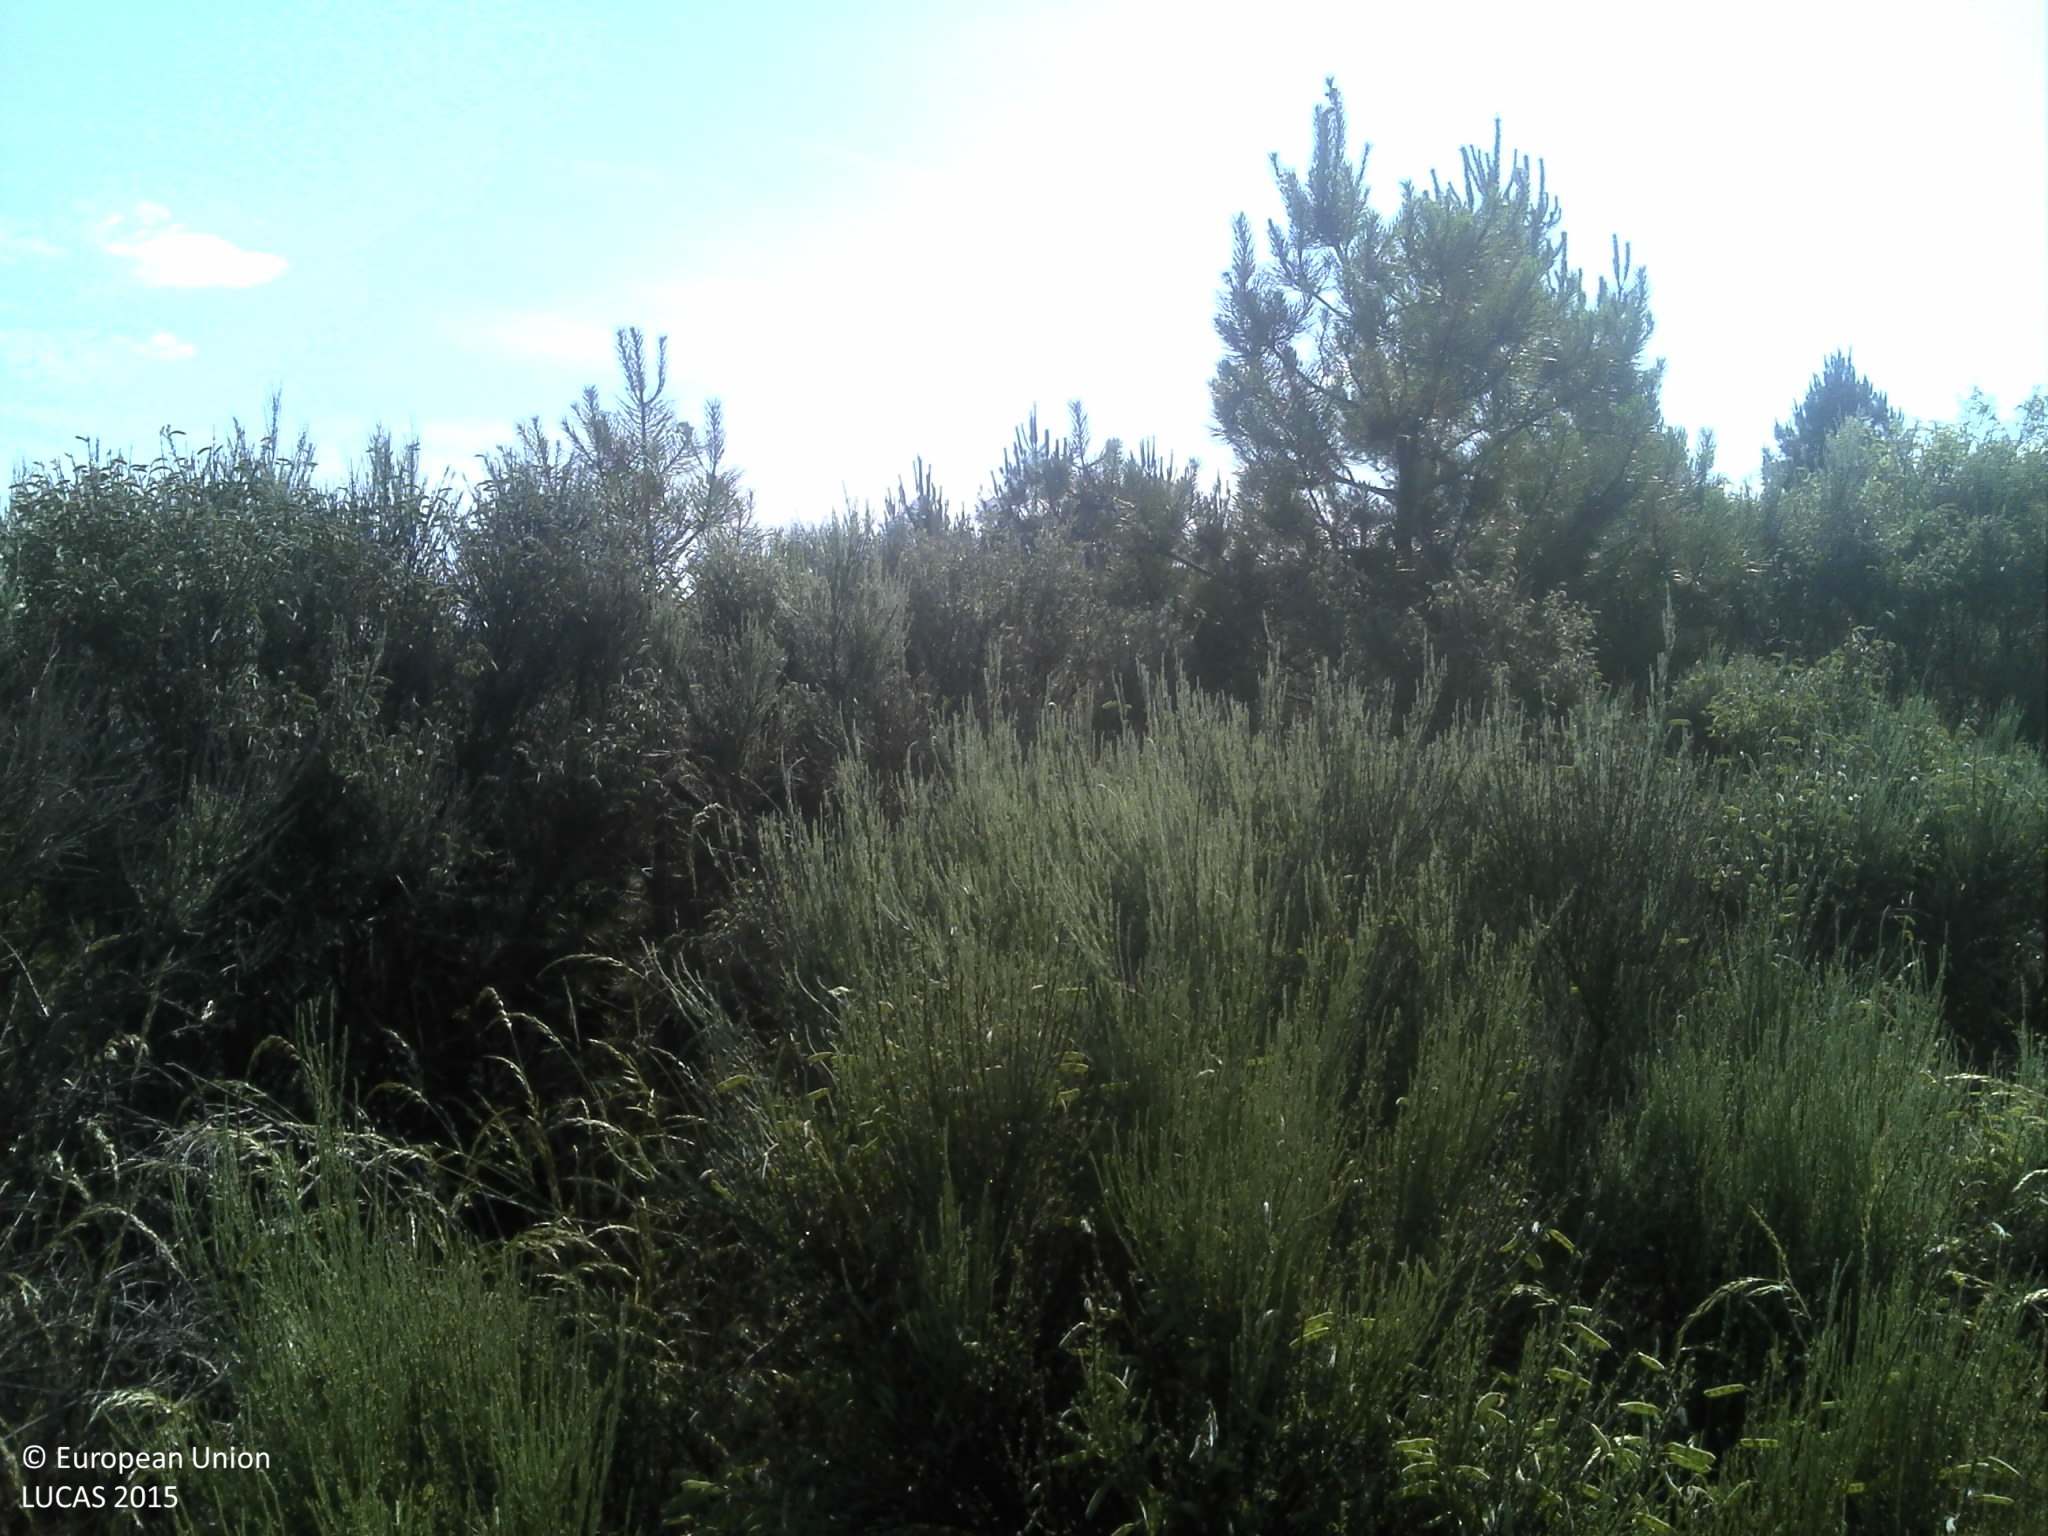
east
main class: Shrubland
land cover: Shrubland with sparse tree cover
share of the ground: 50 - 75 %
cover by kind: shrubs 75 %, unconsolidated bare surface 15 %, broadleaved forest trees 5 %, herbaceous plants 5 %
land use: Semi-natural and natural areas not in use
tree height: < 5 m
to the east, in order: Shrubland with sparse tree cover; Rocks and stones; Shrubland with sparse tree cover; Rocks and stones; Shrubland with sparse tree cover; Tracks; Shrubland with sparse tree cover
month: June
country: PT
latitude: 40.4001
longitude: -7.1739
